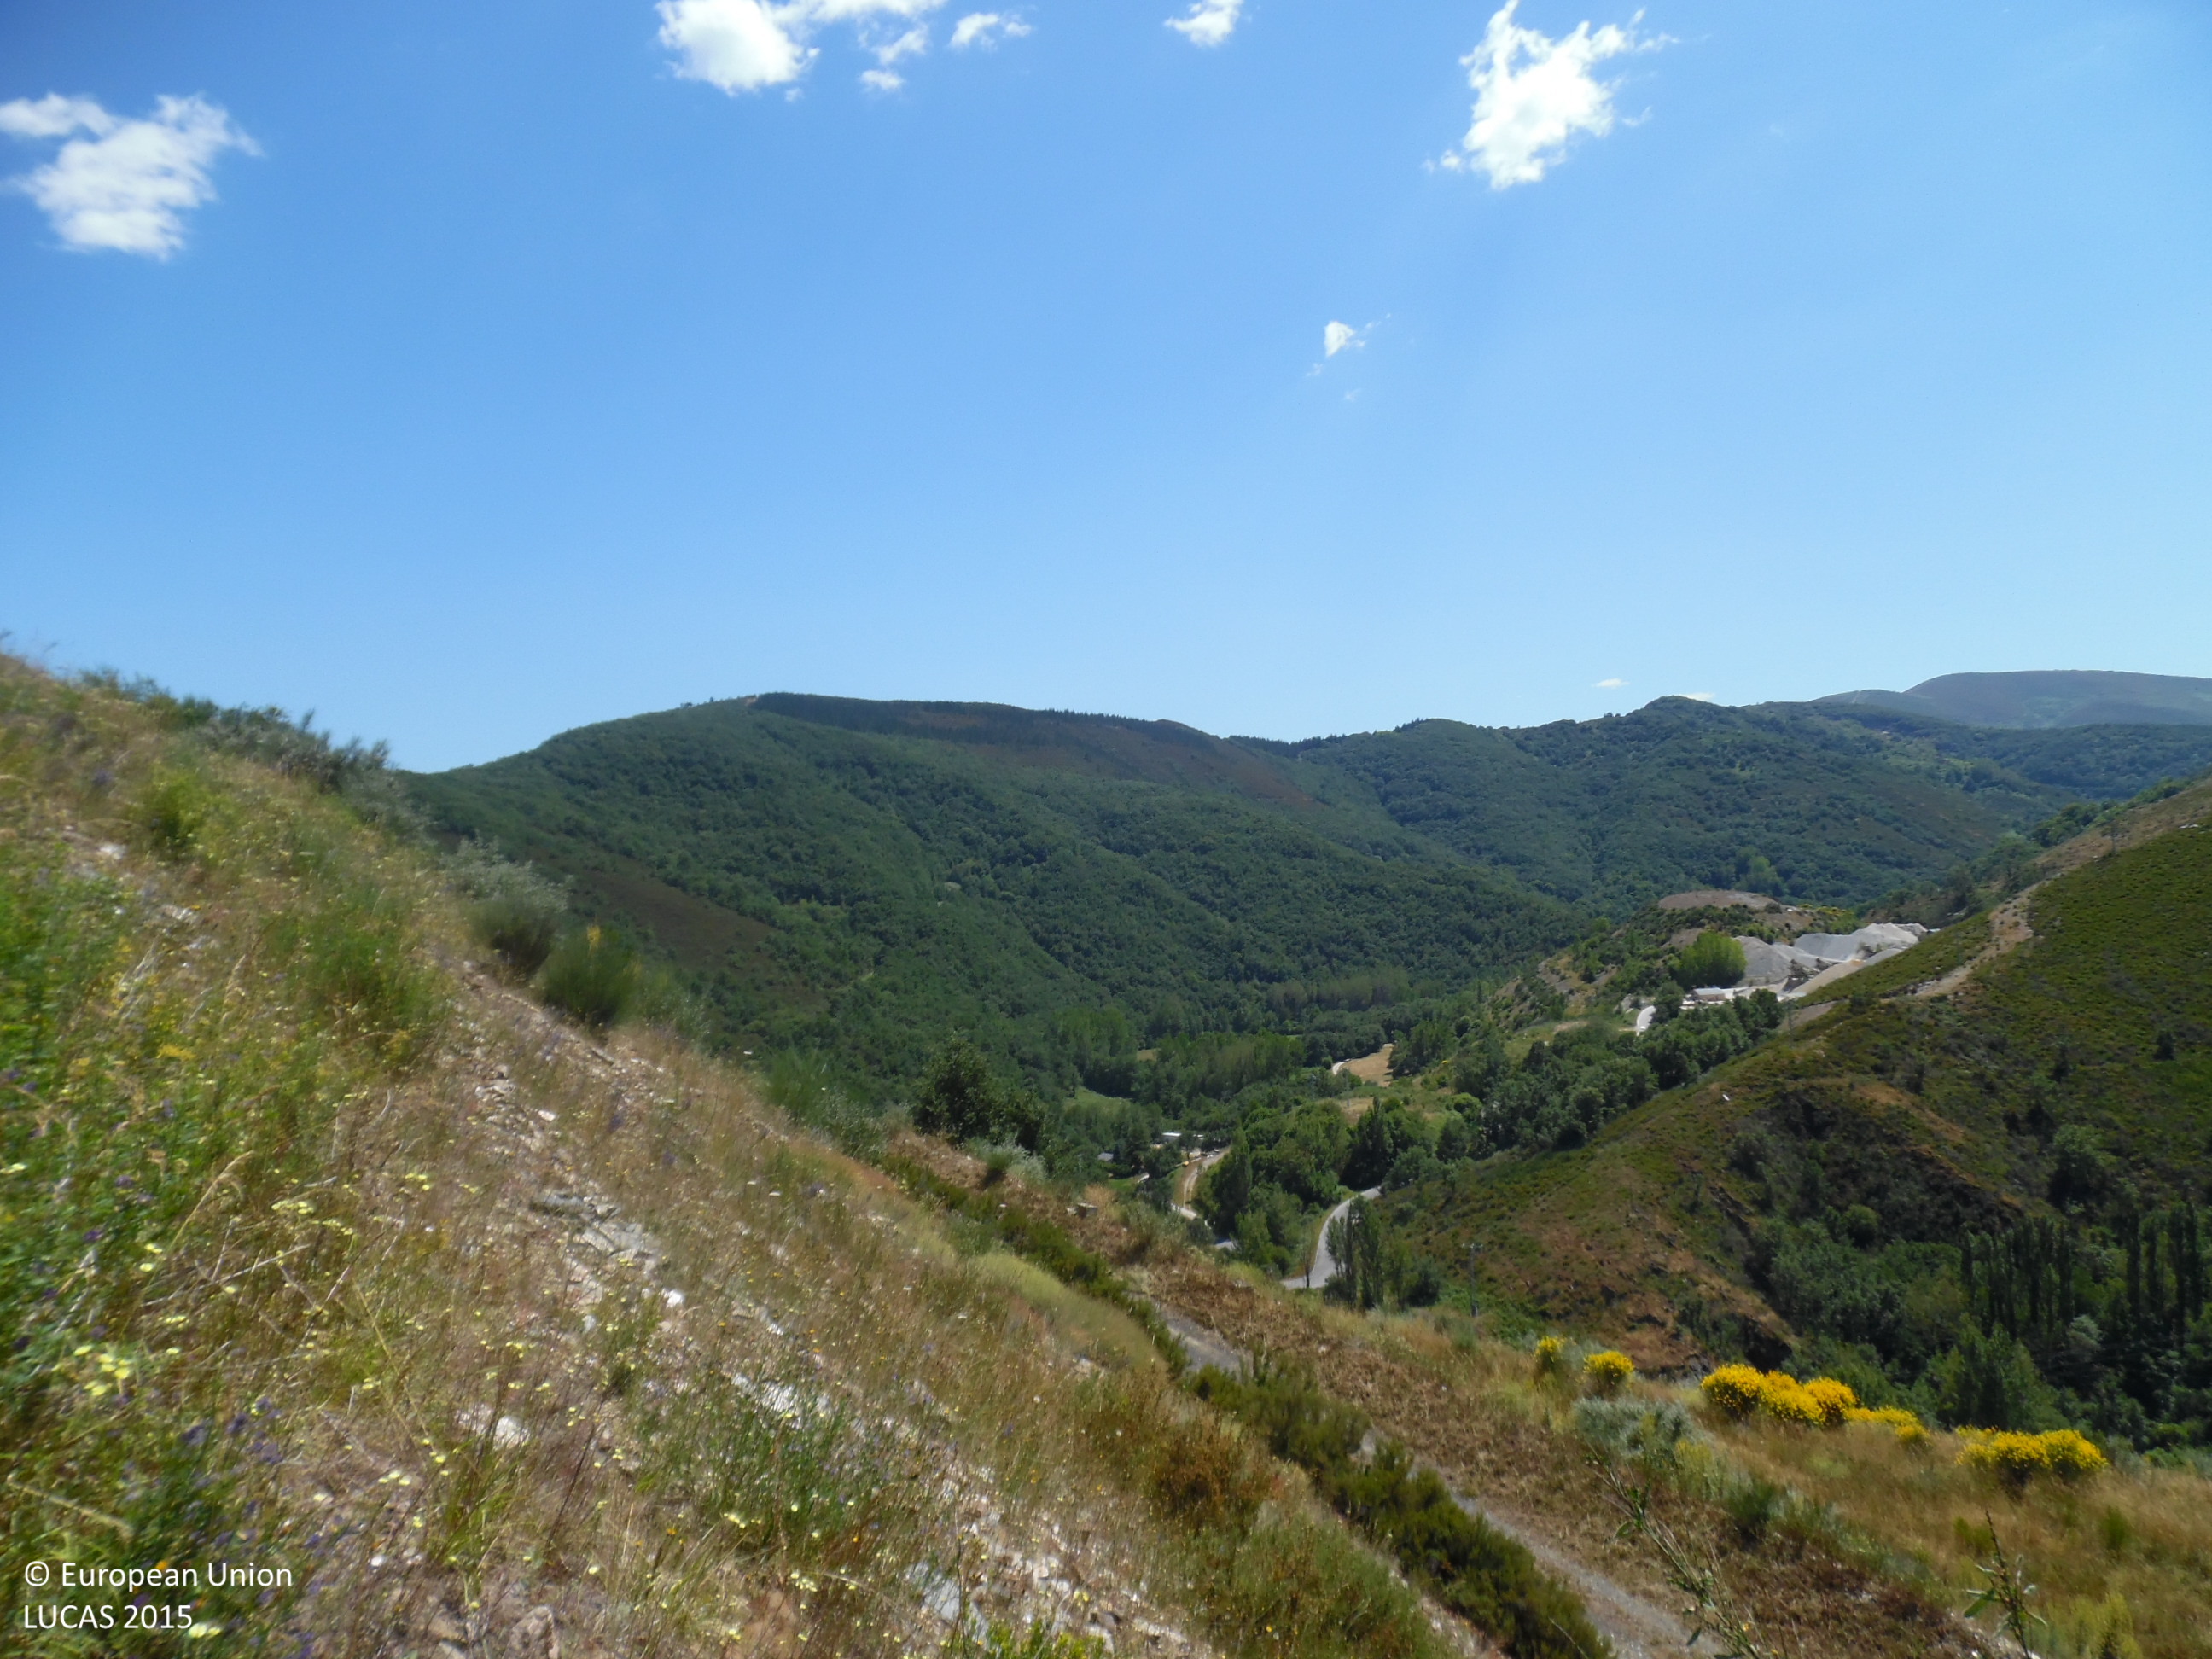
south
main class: Grassland
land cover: Grassland with sparse tree/shrub cover
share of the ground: > 75 %
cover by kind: herbaceous plants 95 %, broadleaved forest trees 5 %
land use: Abandoned areas
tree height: < 5 m
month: June
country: ES
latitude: 42.6572
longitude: -6.9025
